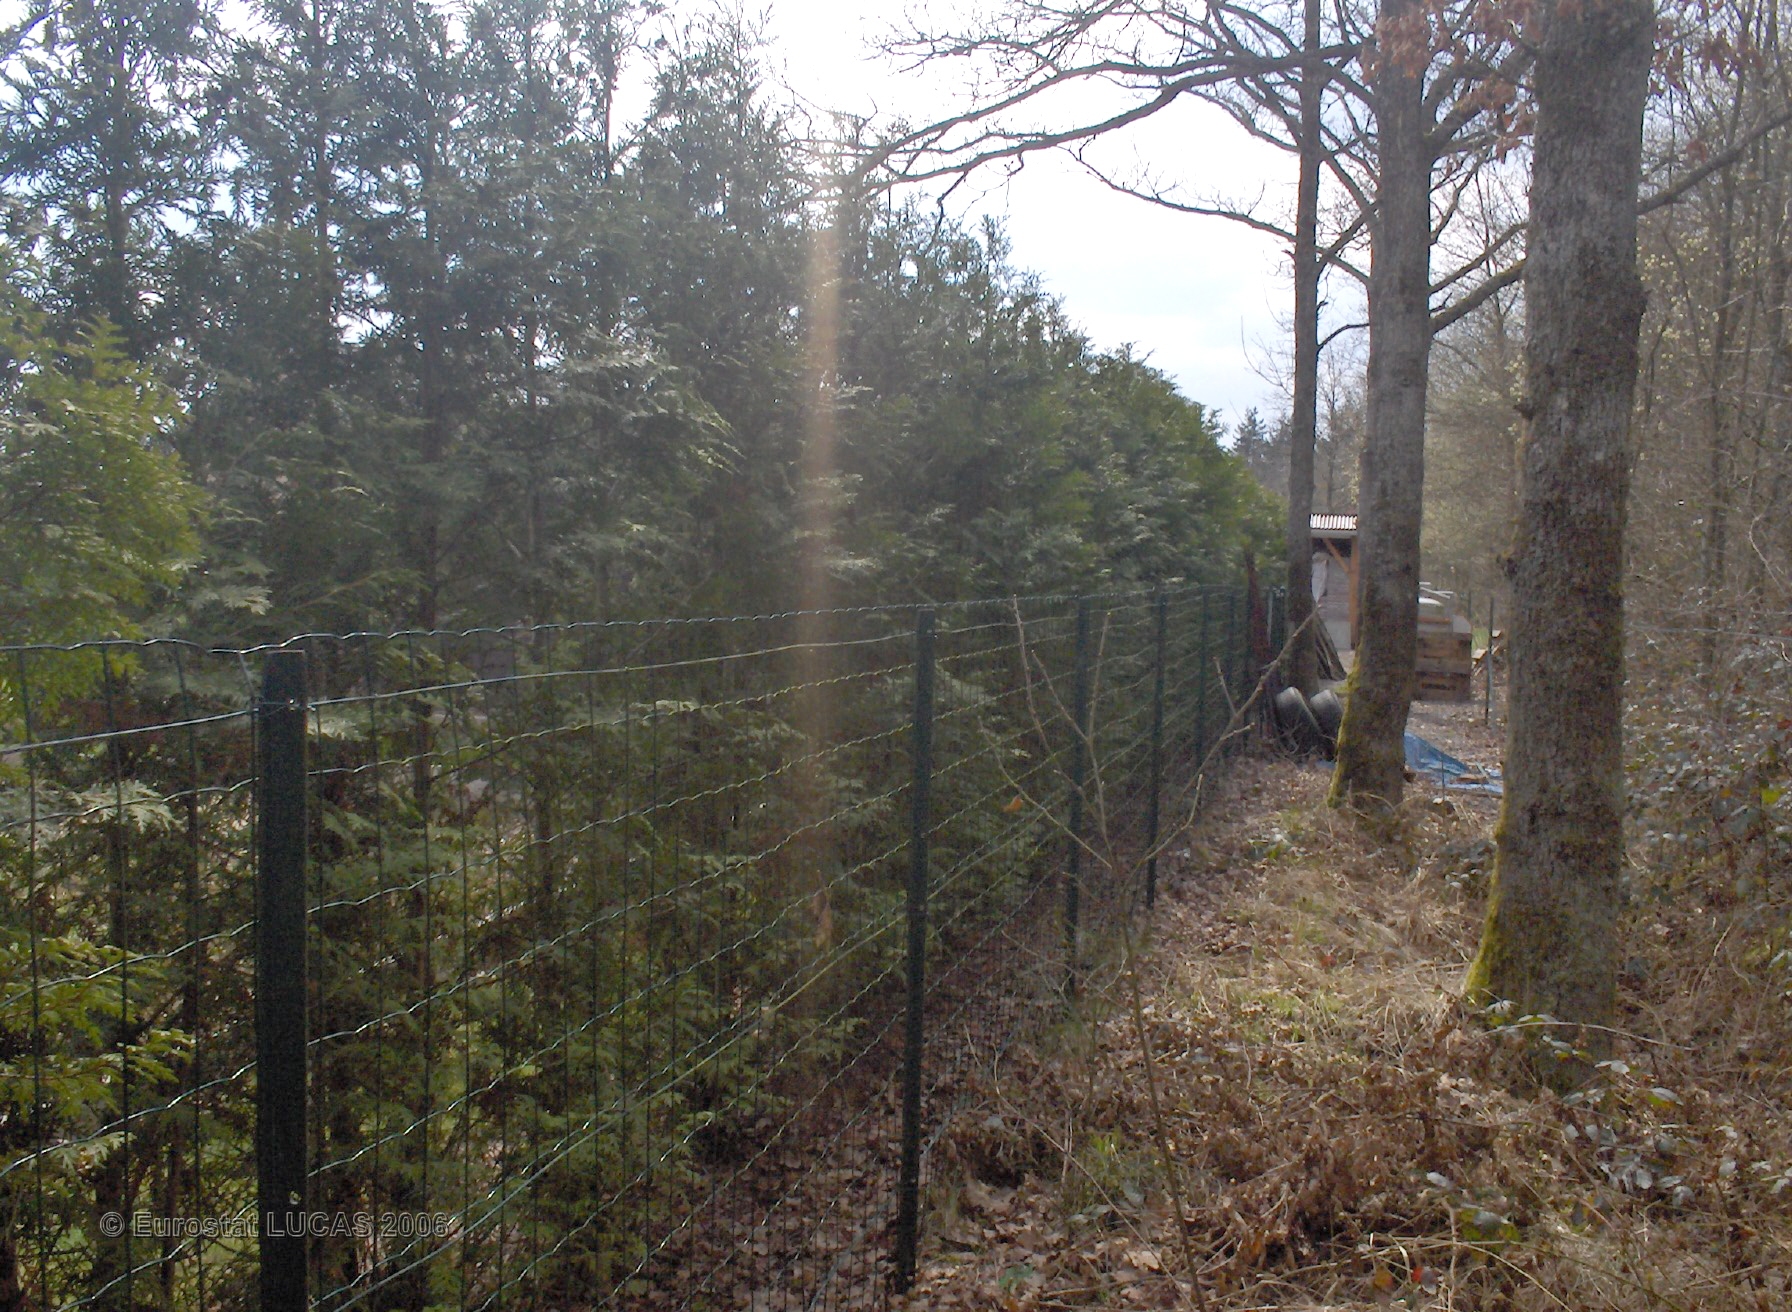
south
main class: Woodland
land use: Residential
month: April
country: BE
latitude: 50.1070
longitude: 4.5290
